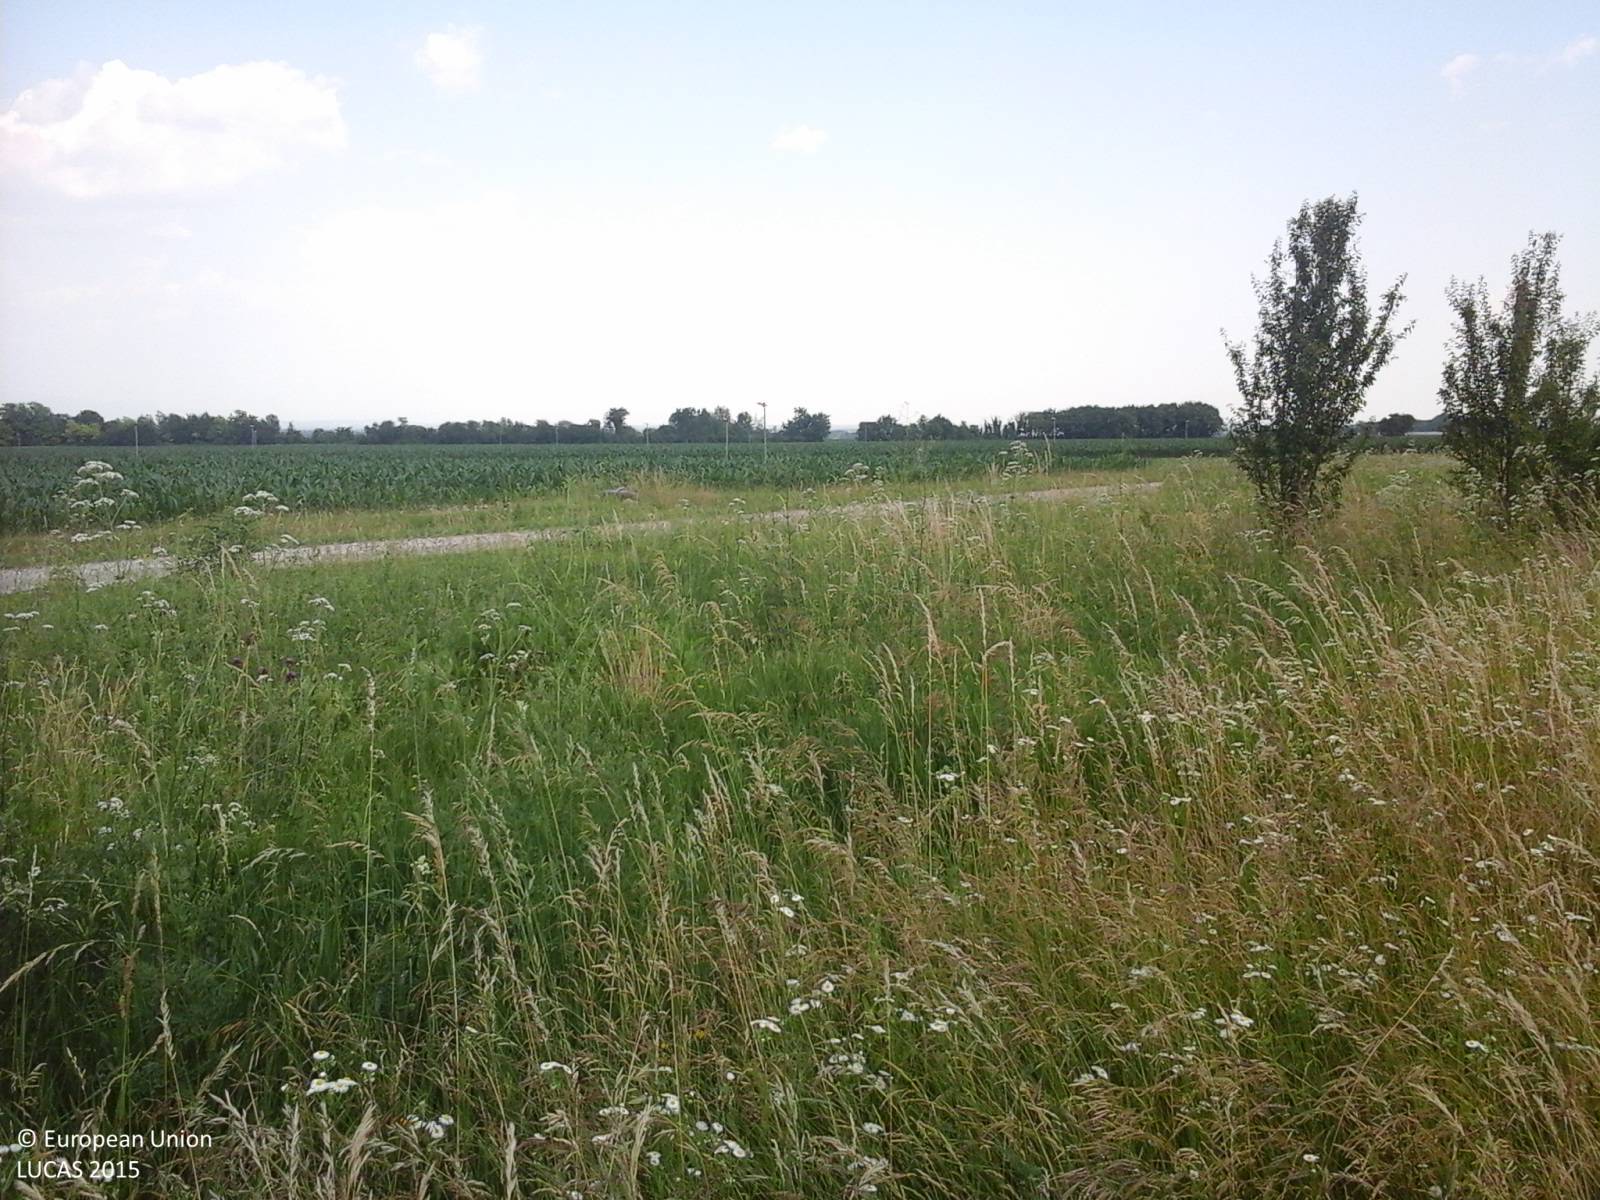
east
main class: Grassland
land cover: Grassland without tree/shrub cover
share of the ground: > 75 %
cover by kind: herbaceous plants 100 %
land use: Agriculture (excluding fallow land and kitchen gardens)
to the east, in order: Grassland without tree/shrub cover
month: June
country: IT
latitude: 46.1362
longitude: 12.7280
